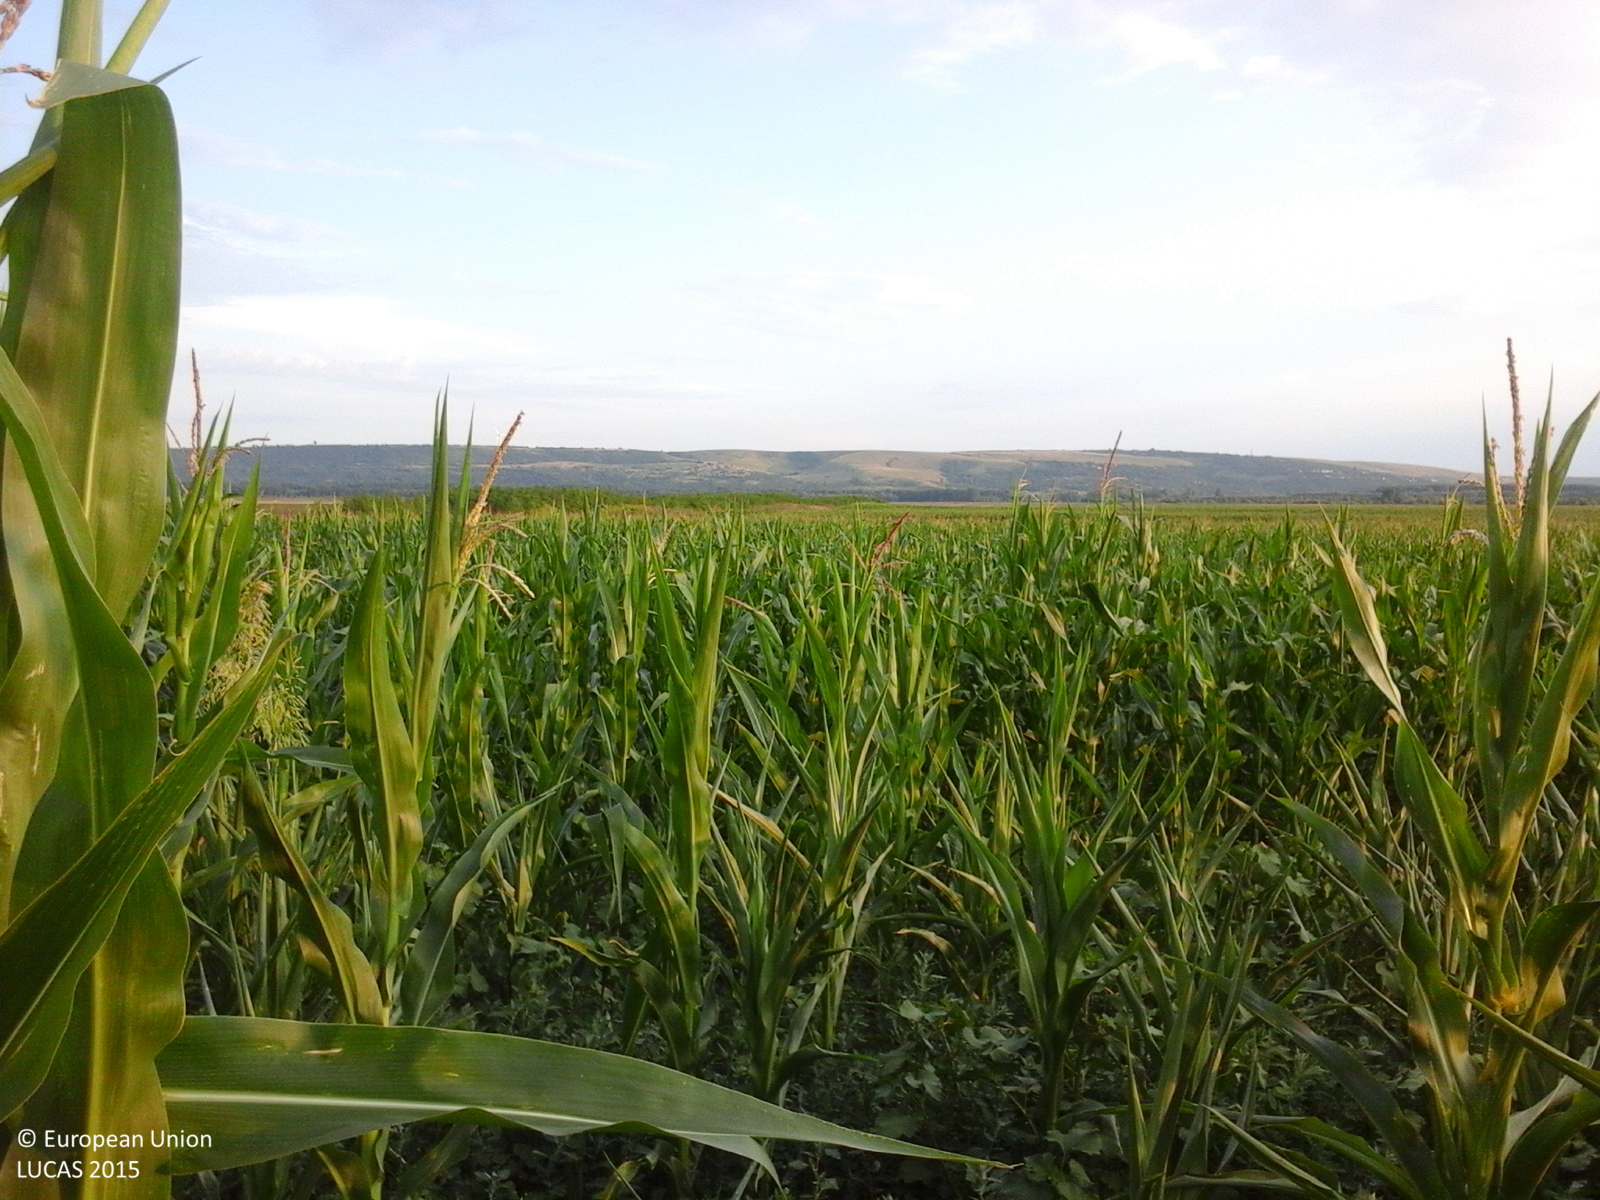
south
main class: Cropland
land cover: Common wheat
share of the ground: > 75 %
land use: Agriculture (excluding fallow land and kitchen gardens)
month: July
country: RO
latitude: 43.7198
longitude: 24.1710
